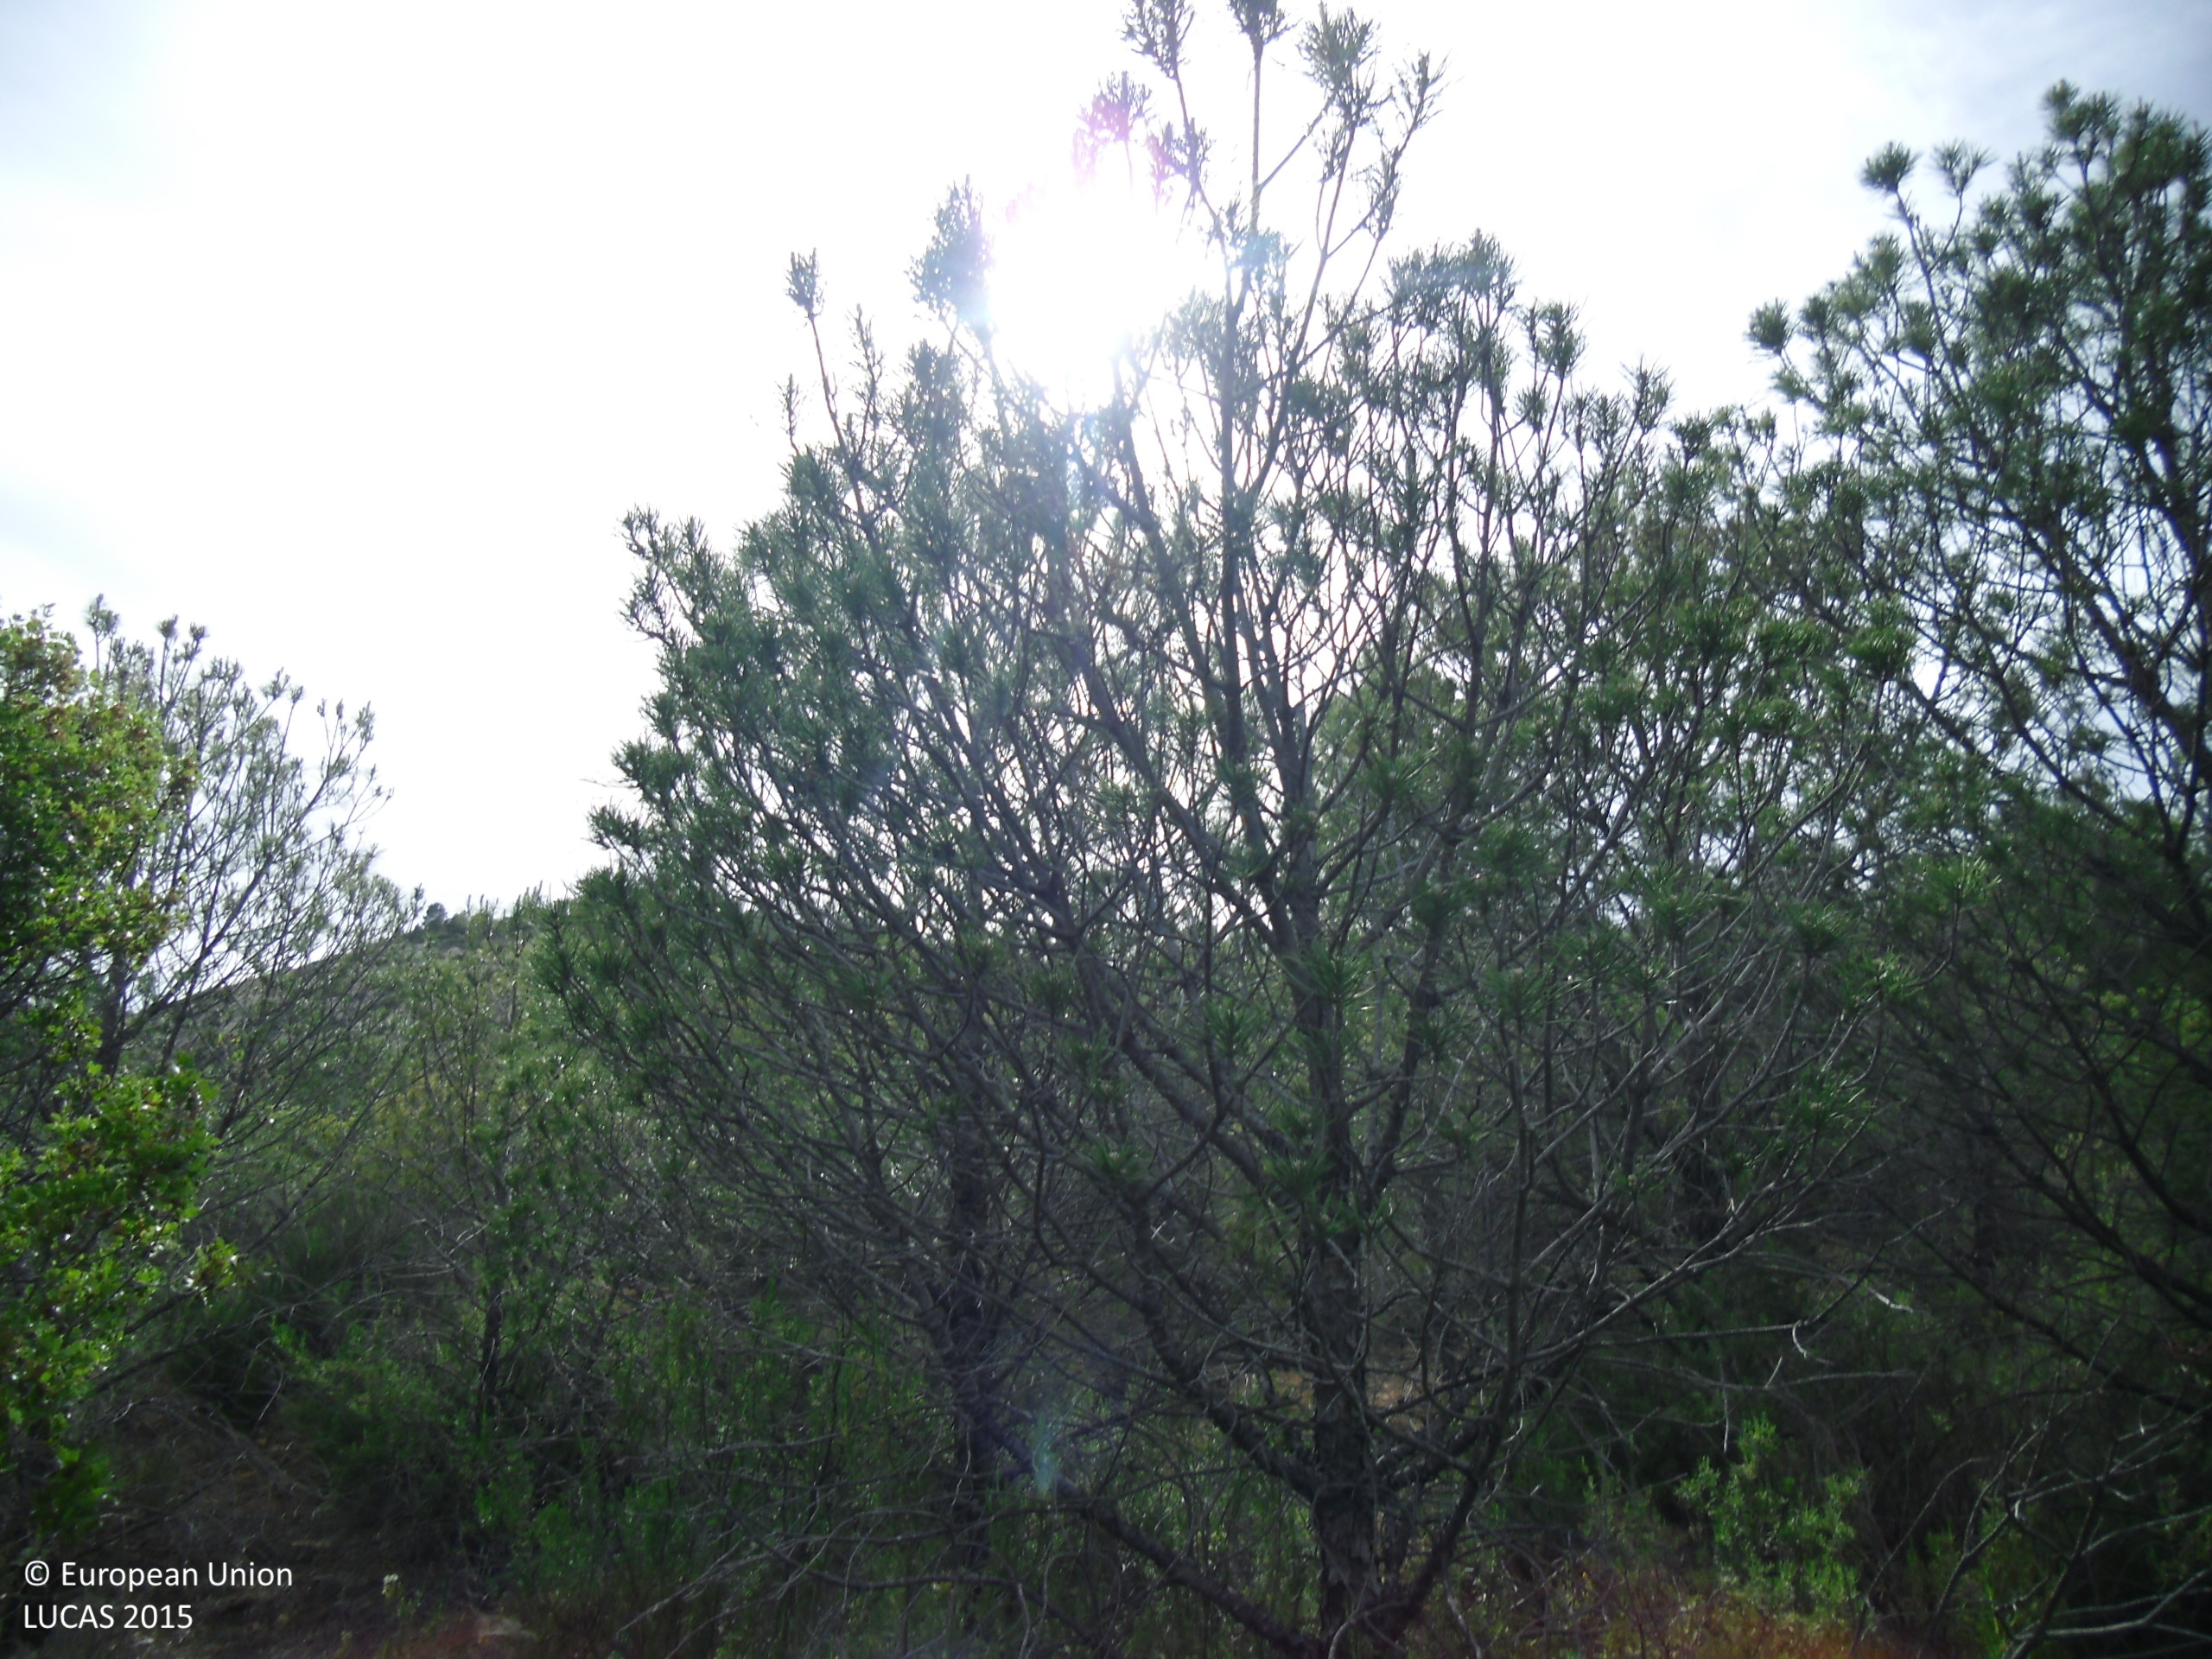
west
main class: Woodland
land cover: Pine dominated coniferous woodland
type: coniferous forest of the mediterranean region
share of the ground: > 75 %
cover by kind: coniferous forest trees 85 %, herbaceous plants 10 %, unconsolidated bare surface 5 %
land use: Forestry
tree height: > 5 m
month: May
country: ES
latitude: 40.3634
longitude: -2.8981
